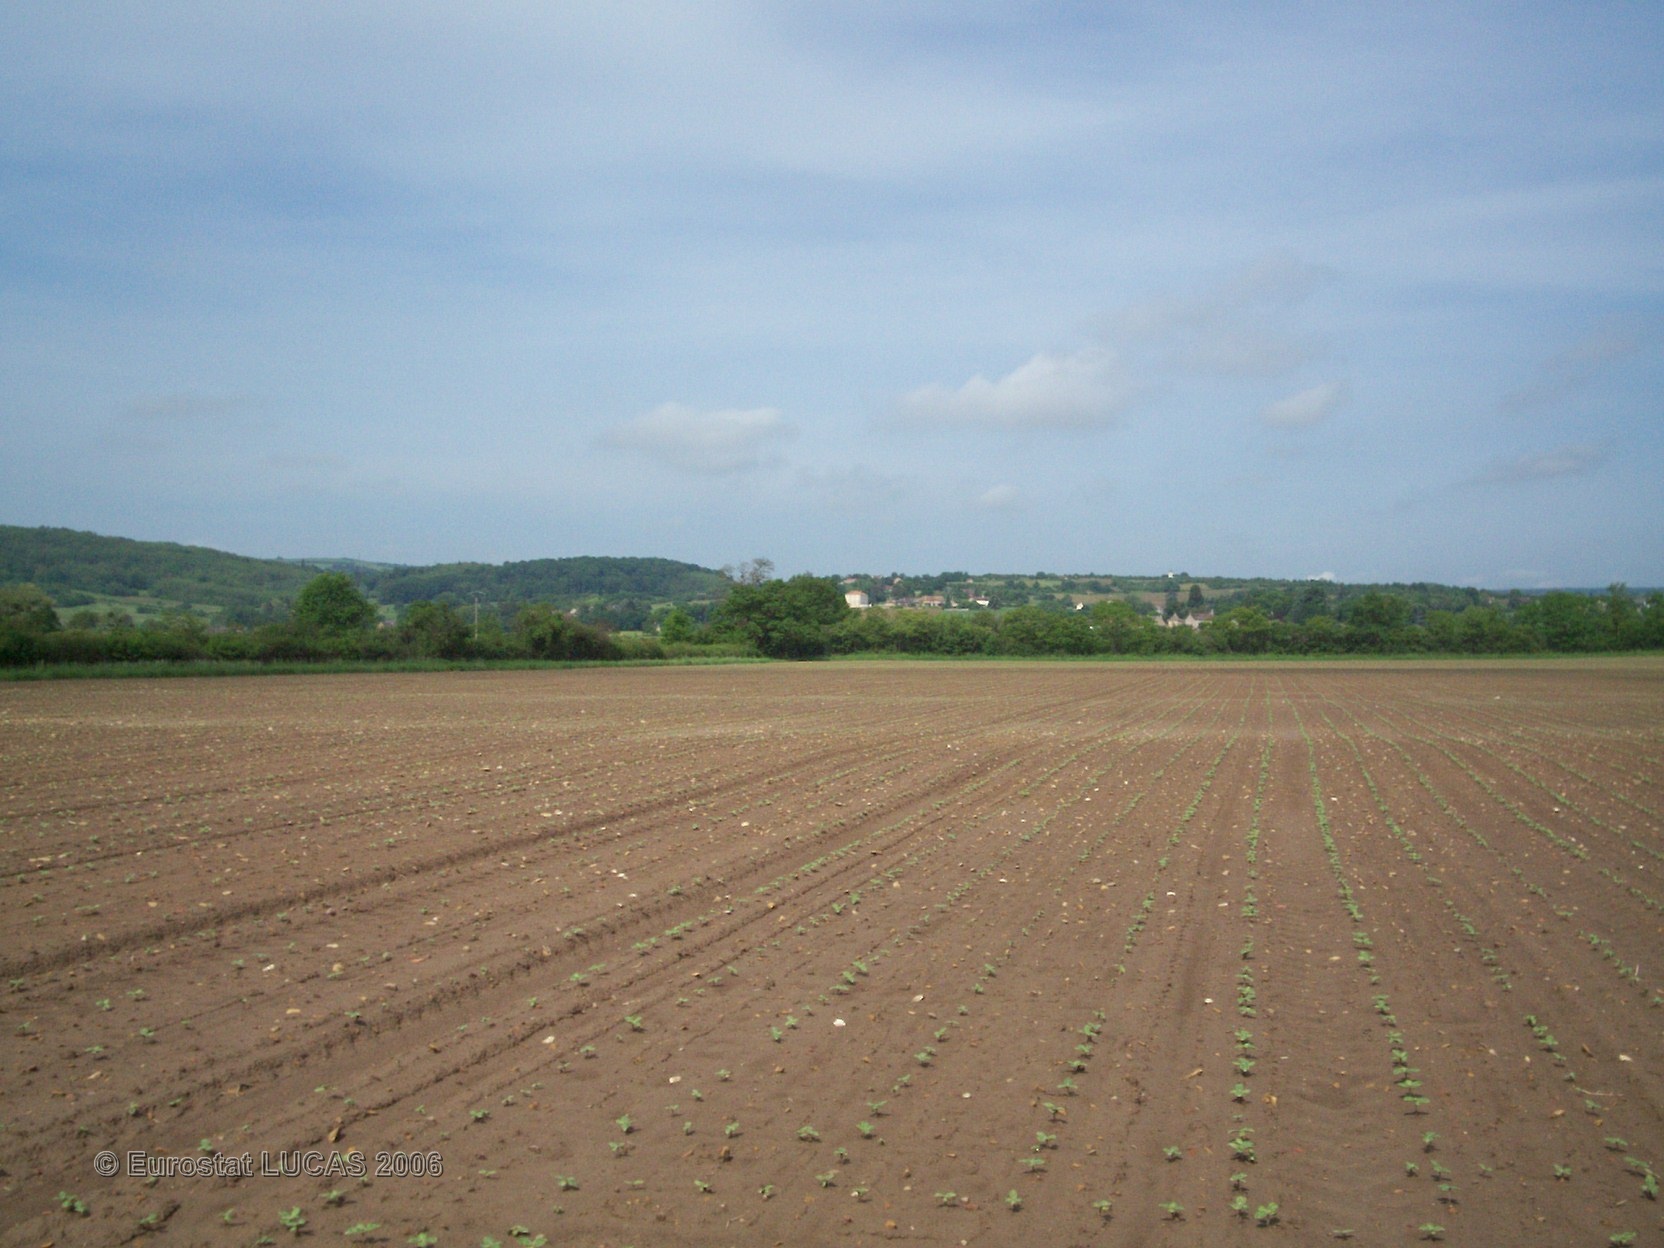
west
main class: Cropland
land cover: Sunflower
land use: Agriculture (excluding fallow land and kitchen gardens)
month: May
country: FR
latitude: 46.7445
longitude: 4.7263
